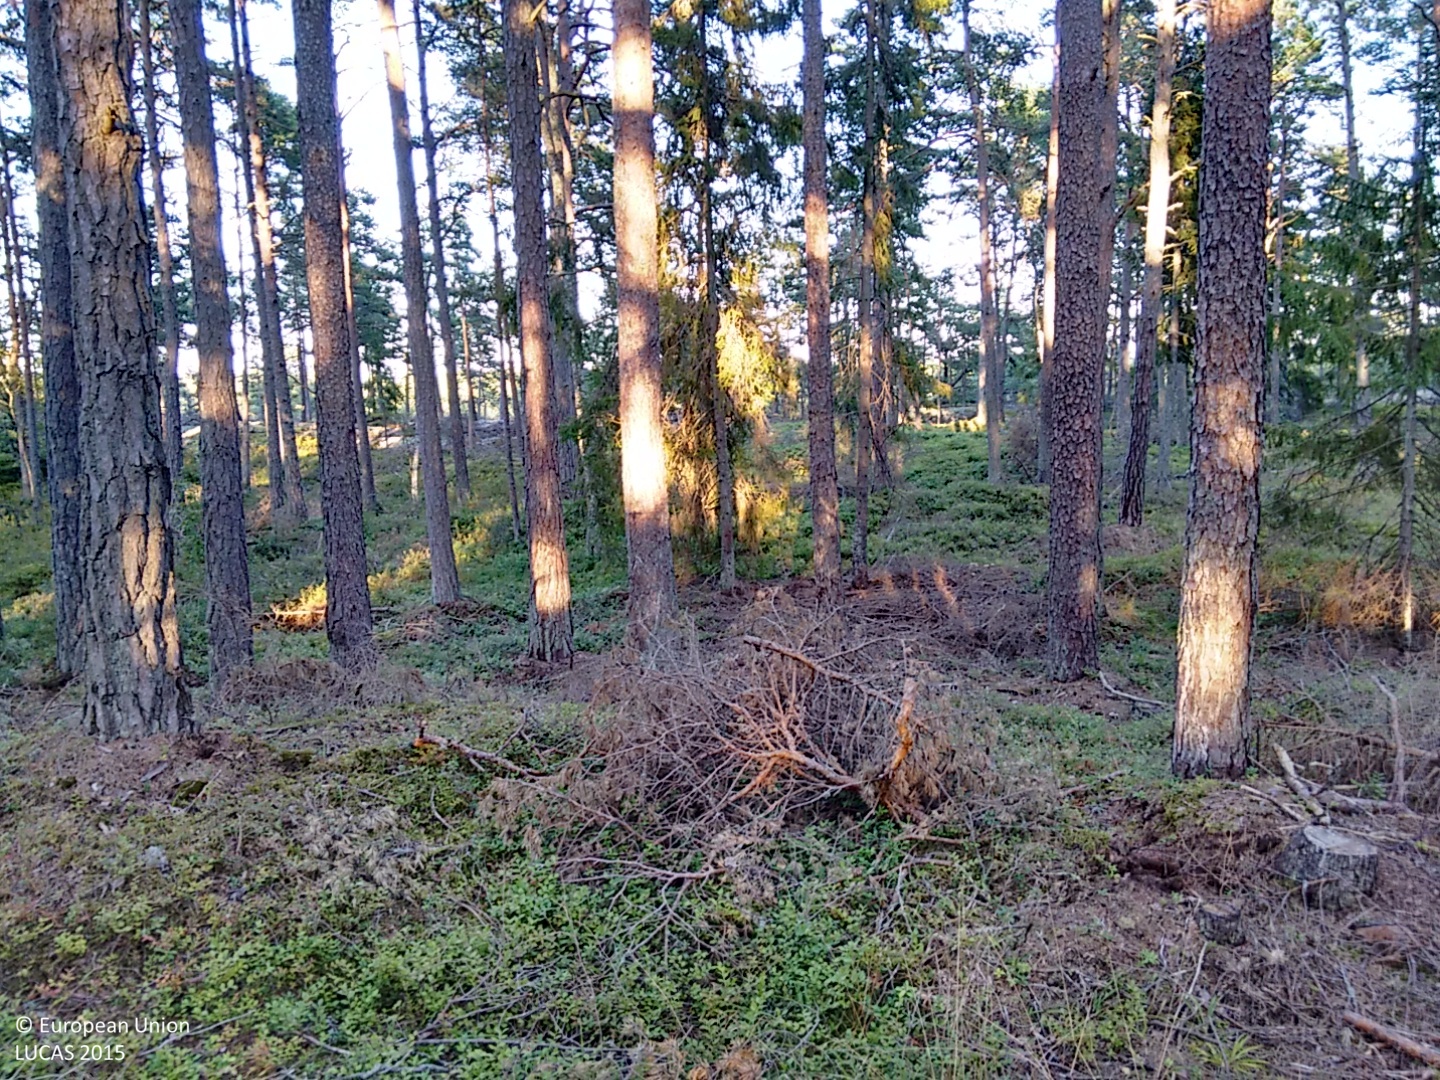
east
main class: Woodland
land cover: Pine dominated coniferous woodland
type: hemiboreal forest and nemoral coniferous forest and mixed broadleaved-coniferous forest
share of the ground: > 75 %
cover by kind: coniferous forest trees 90 %, shrubs 10 %
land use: Forestry
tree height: > 5 m
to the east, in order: Pine dominated coniferous woodland; Ditches and canals; Oats; Grass margins; Ditches and canals; Grass margins; Other root crops; Electric lines; Other root crops; Oats
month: August
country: FI
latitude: 60.1157
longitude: 19.9934
